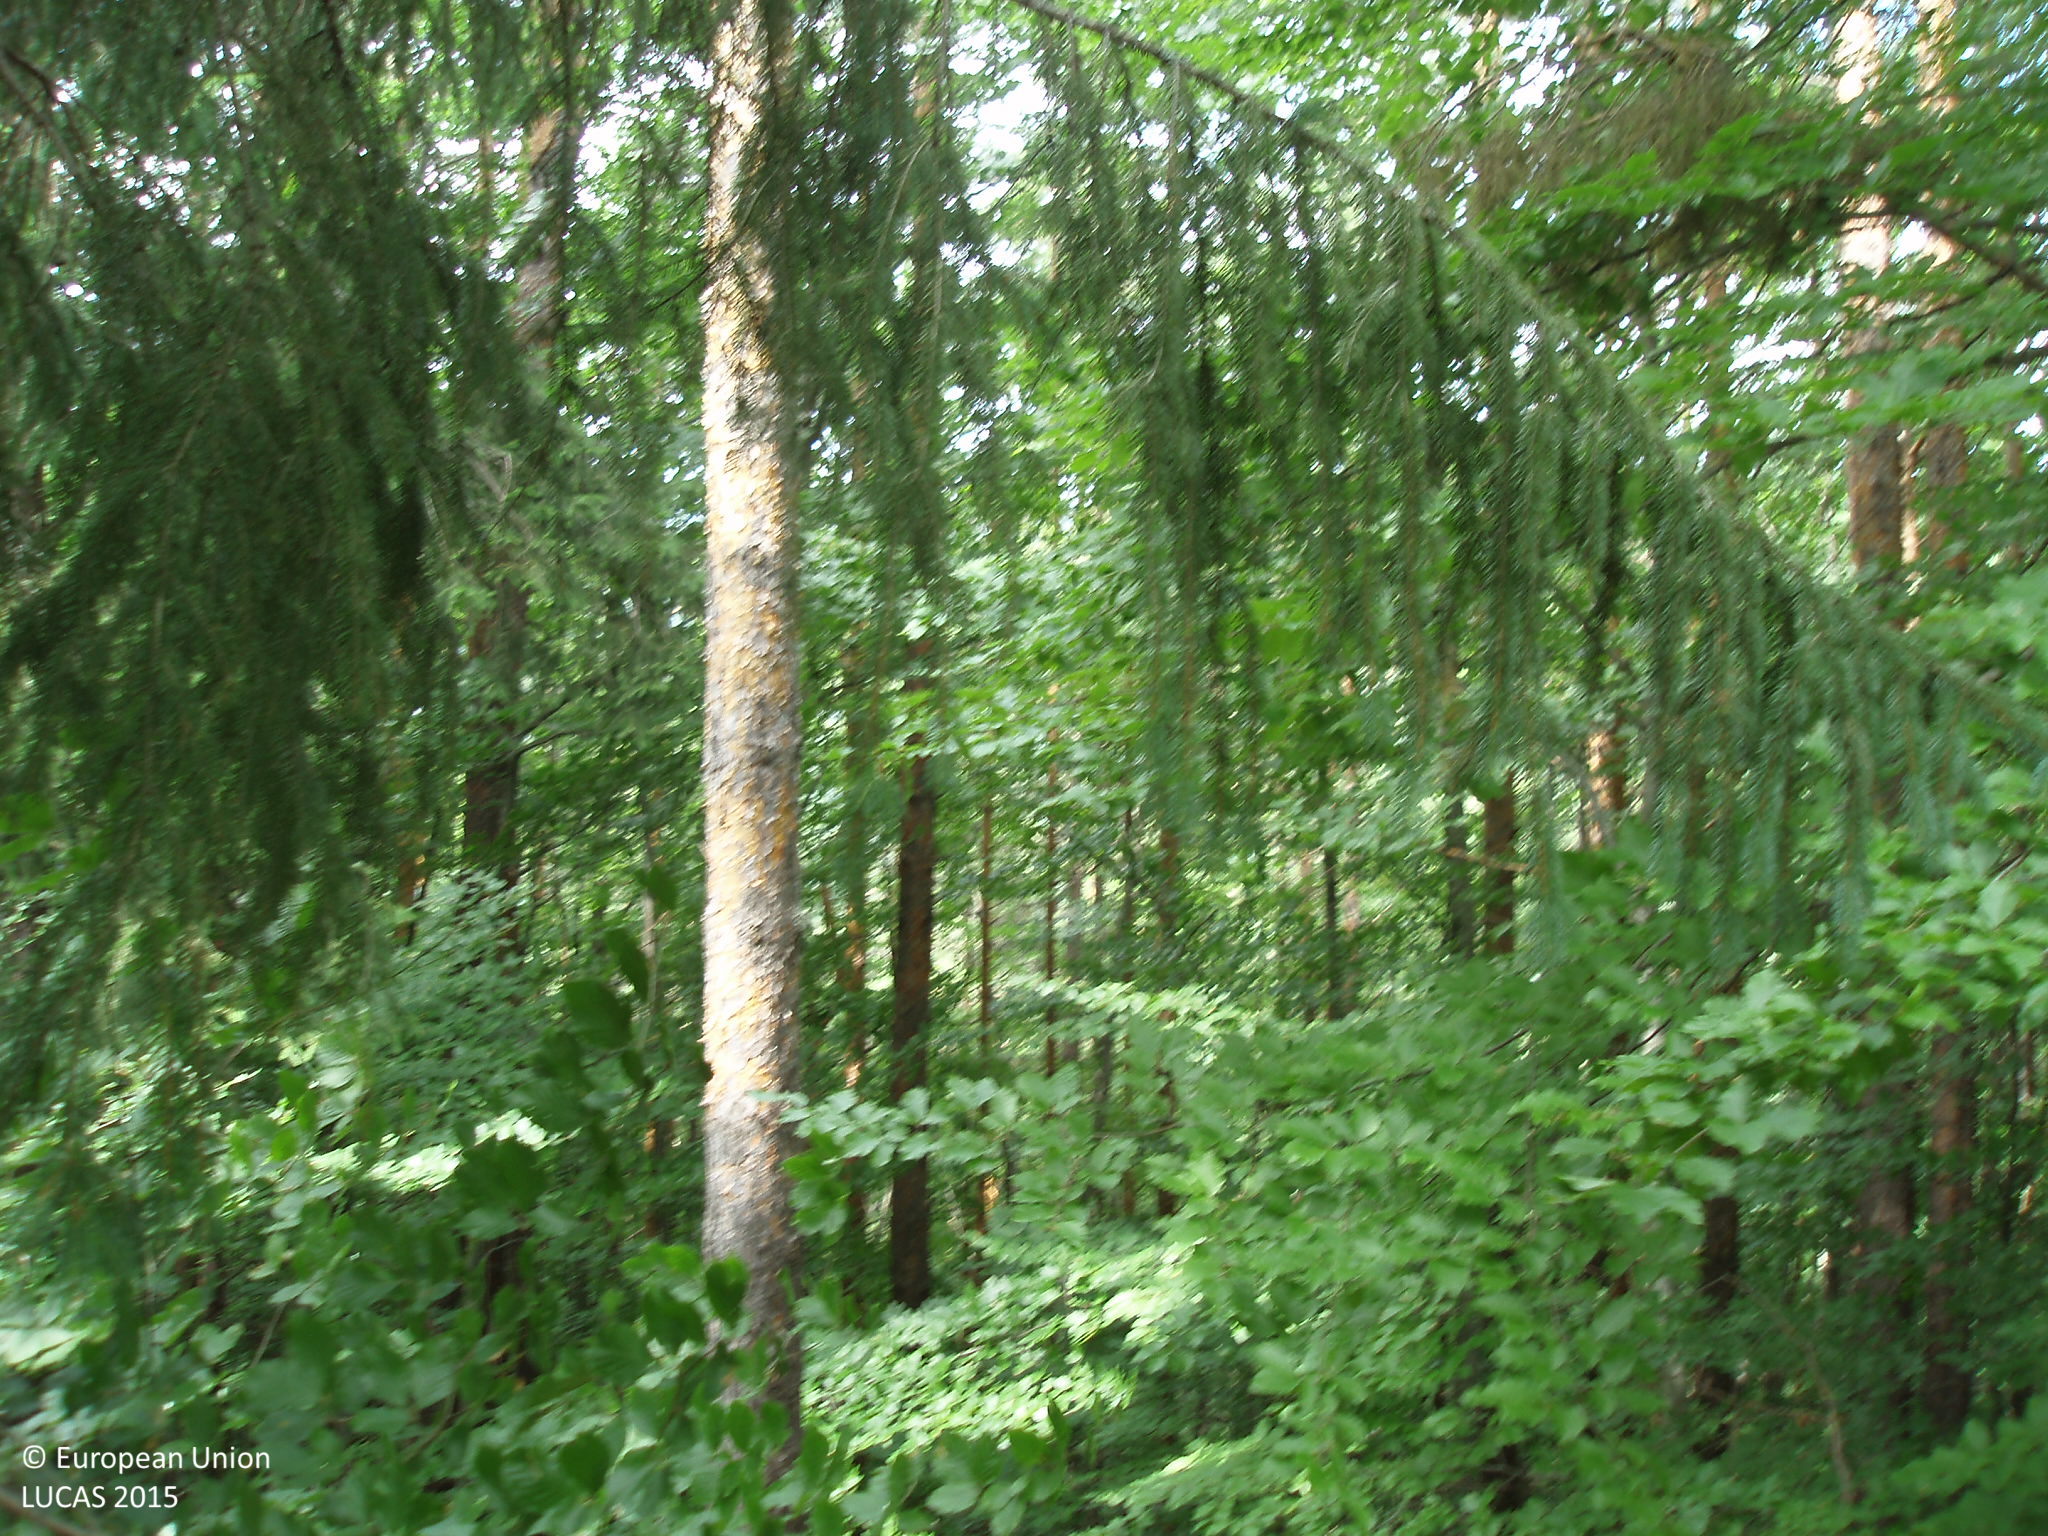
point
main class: Woodland
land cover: Pine dominated mixed woodland
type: hemiboreal forest and nemoral coniferous forest and mixed broadleaved-coniferous forest
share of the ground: > 75 %
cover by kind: coniferous forest trees 75 %, broadleaved forest trees 25 %
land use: Forestry
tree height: > 5 m
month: July
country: BG
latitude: 42.0458
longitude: 23.8444
